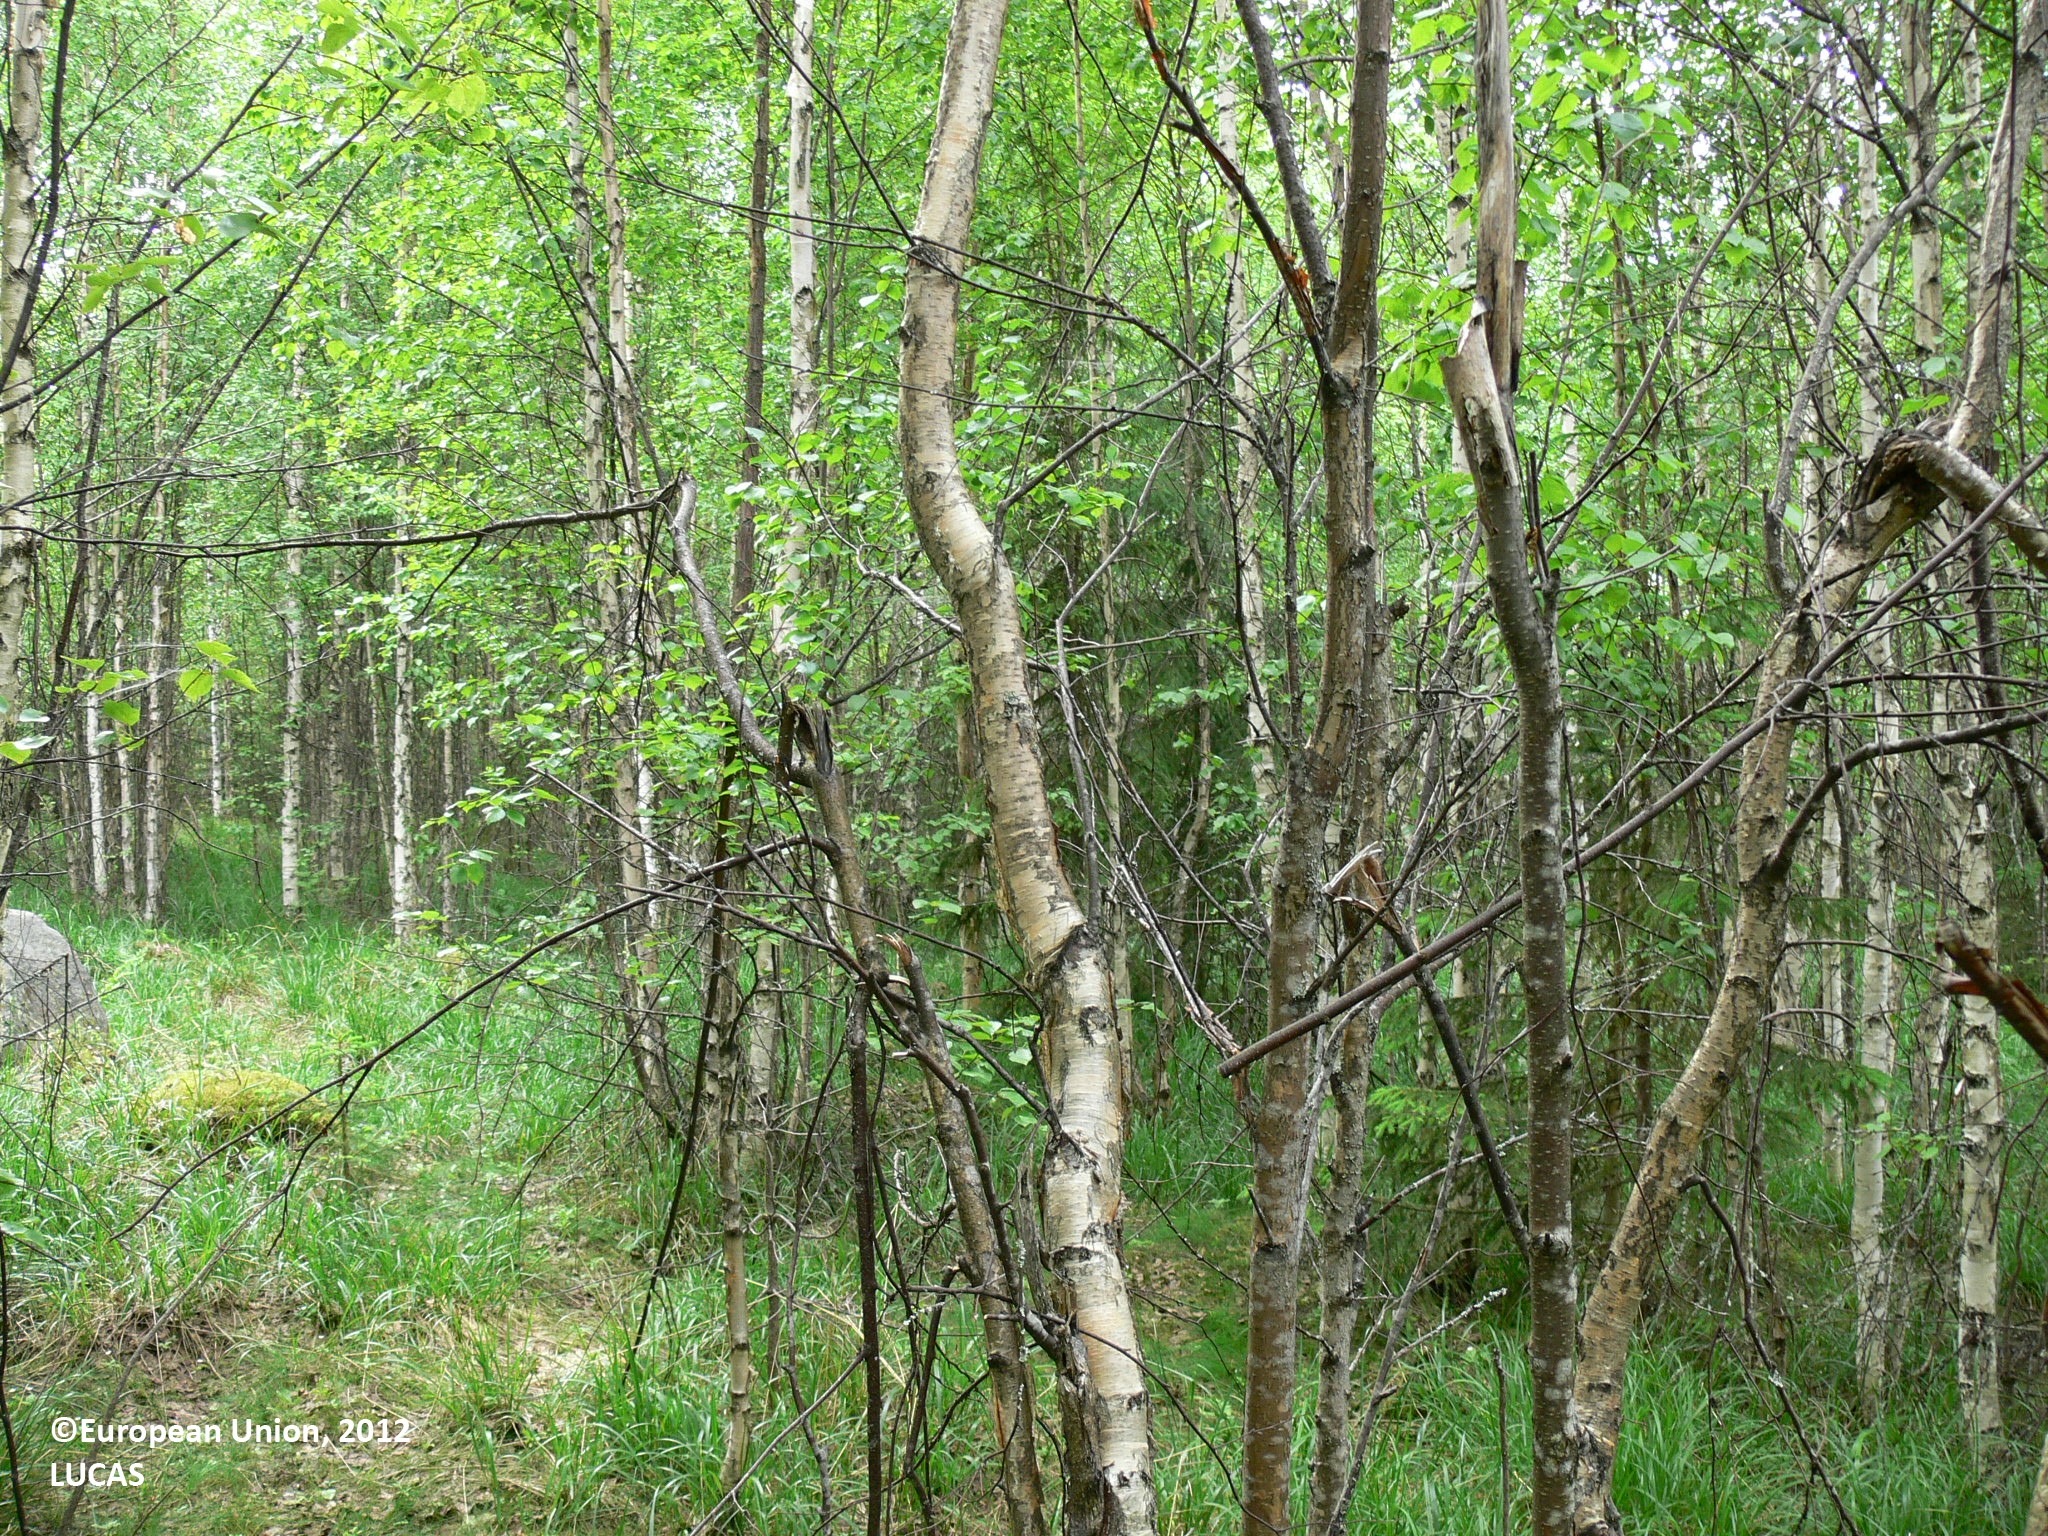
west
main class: Woodland
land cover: Spruce dominated mixed woodland
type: boreal forest
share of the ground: > 75 %
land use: Forestry
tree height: > 5 m
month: June
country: FI
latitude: 62.9835
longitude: 29.7598
